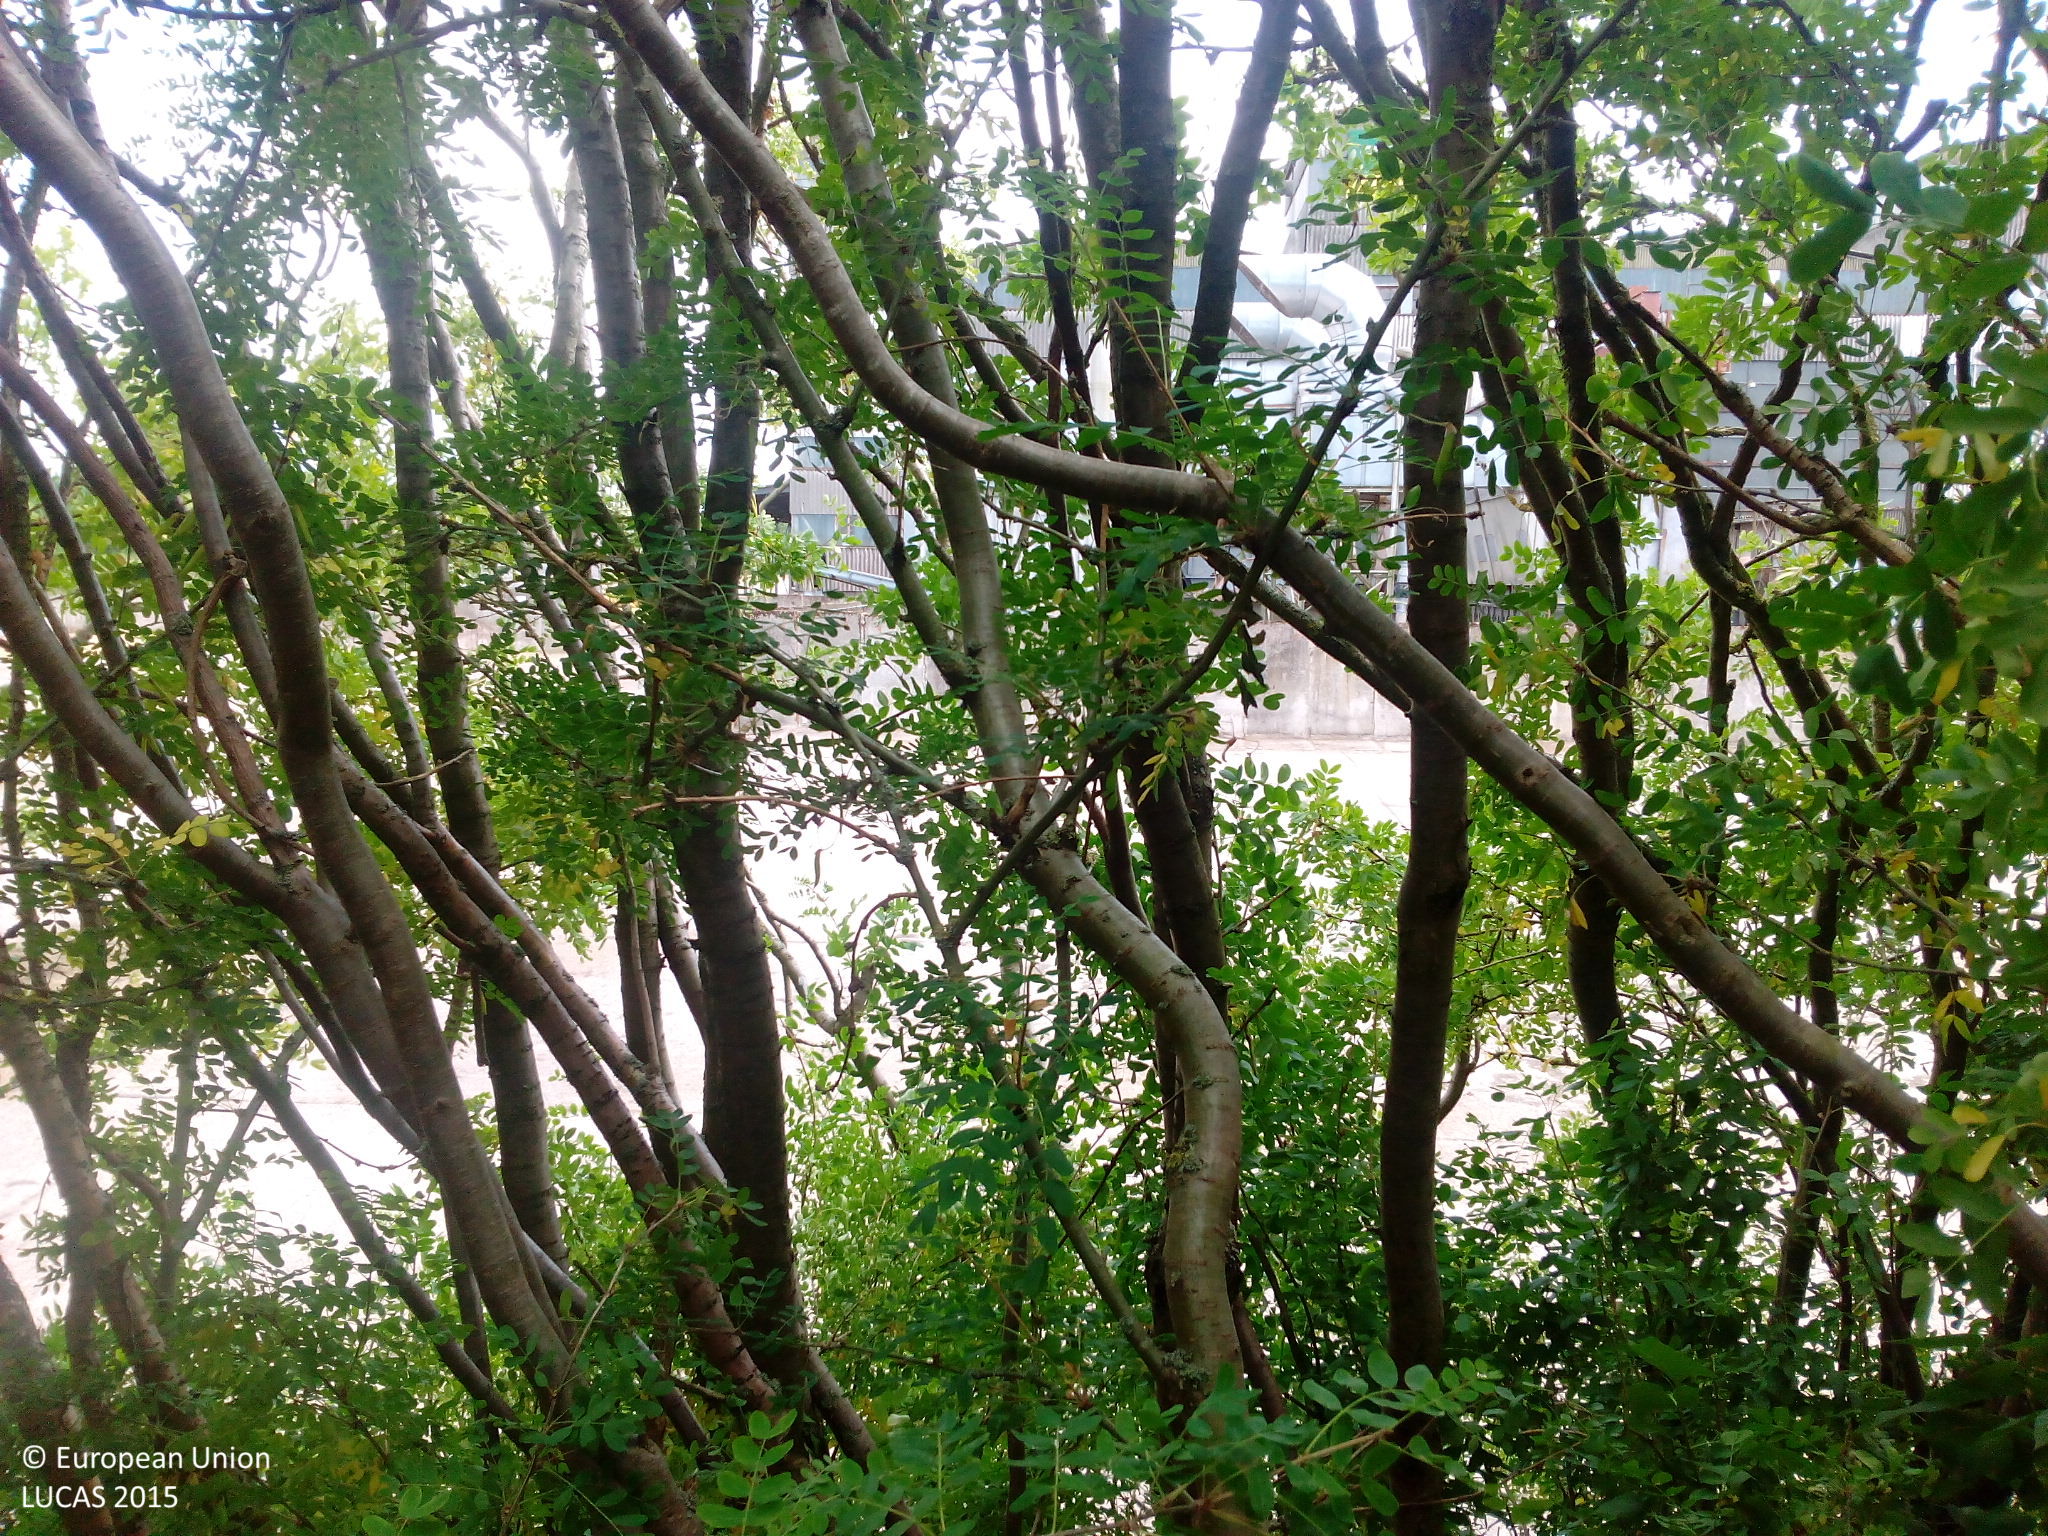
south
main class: Woodland
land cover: Broadleaved woodland
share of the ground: > 75 %
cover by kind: broadleaved forest trees 75 %, herbaceous plants 25 %
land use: Other primary production
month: June
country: DE
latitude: 53.8636
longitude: 11.1702
